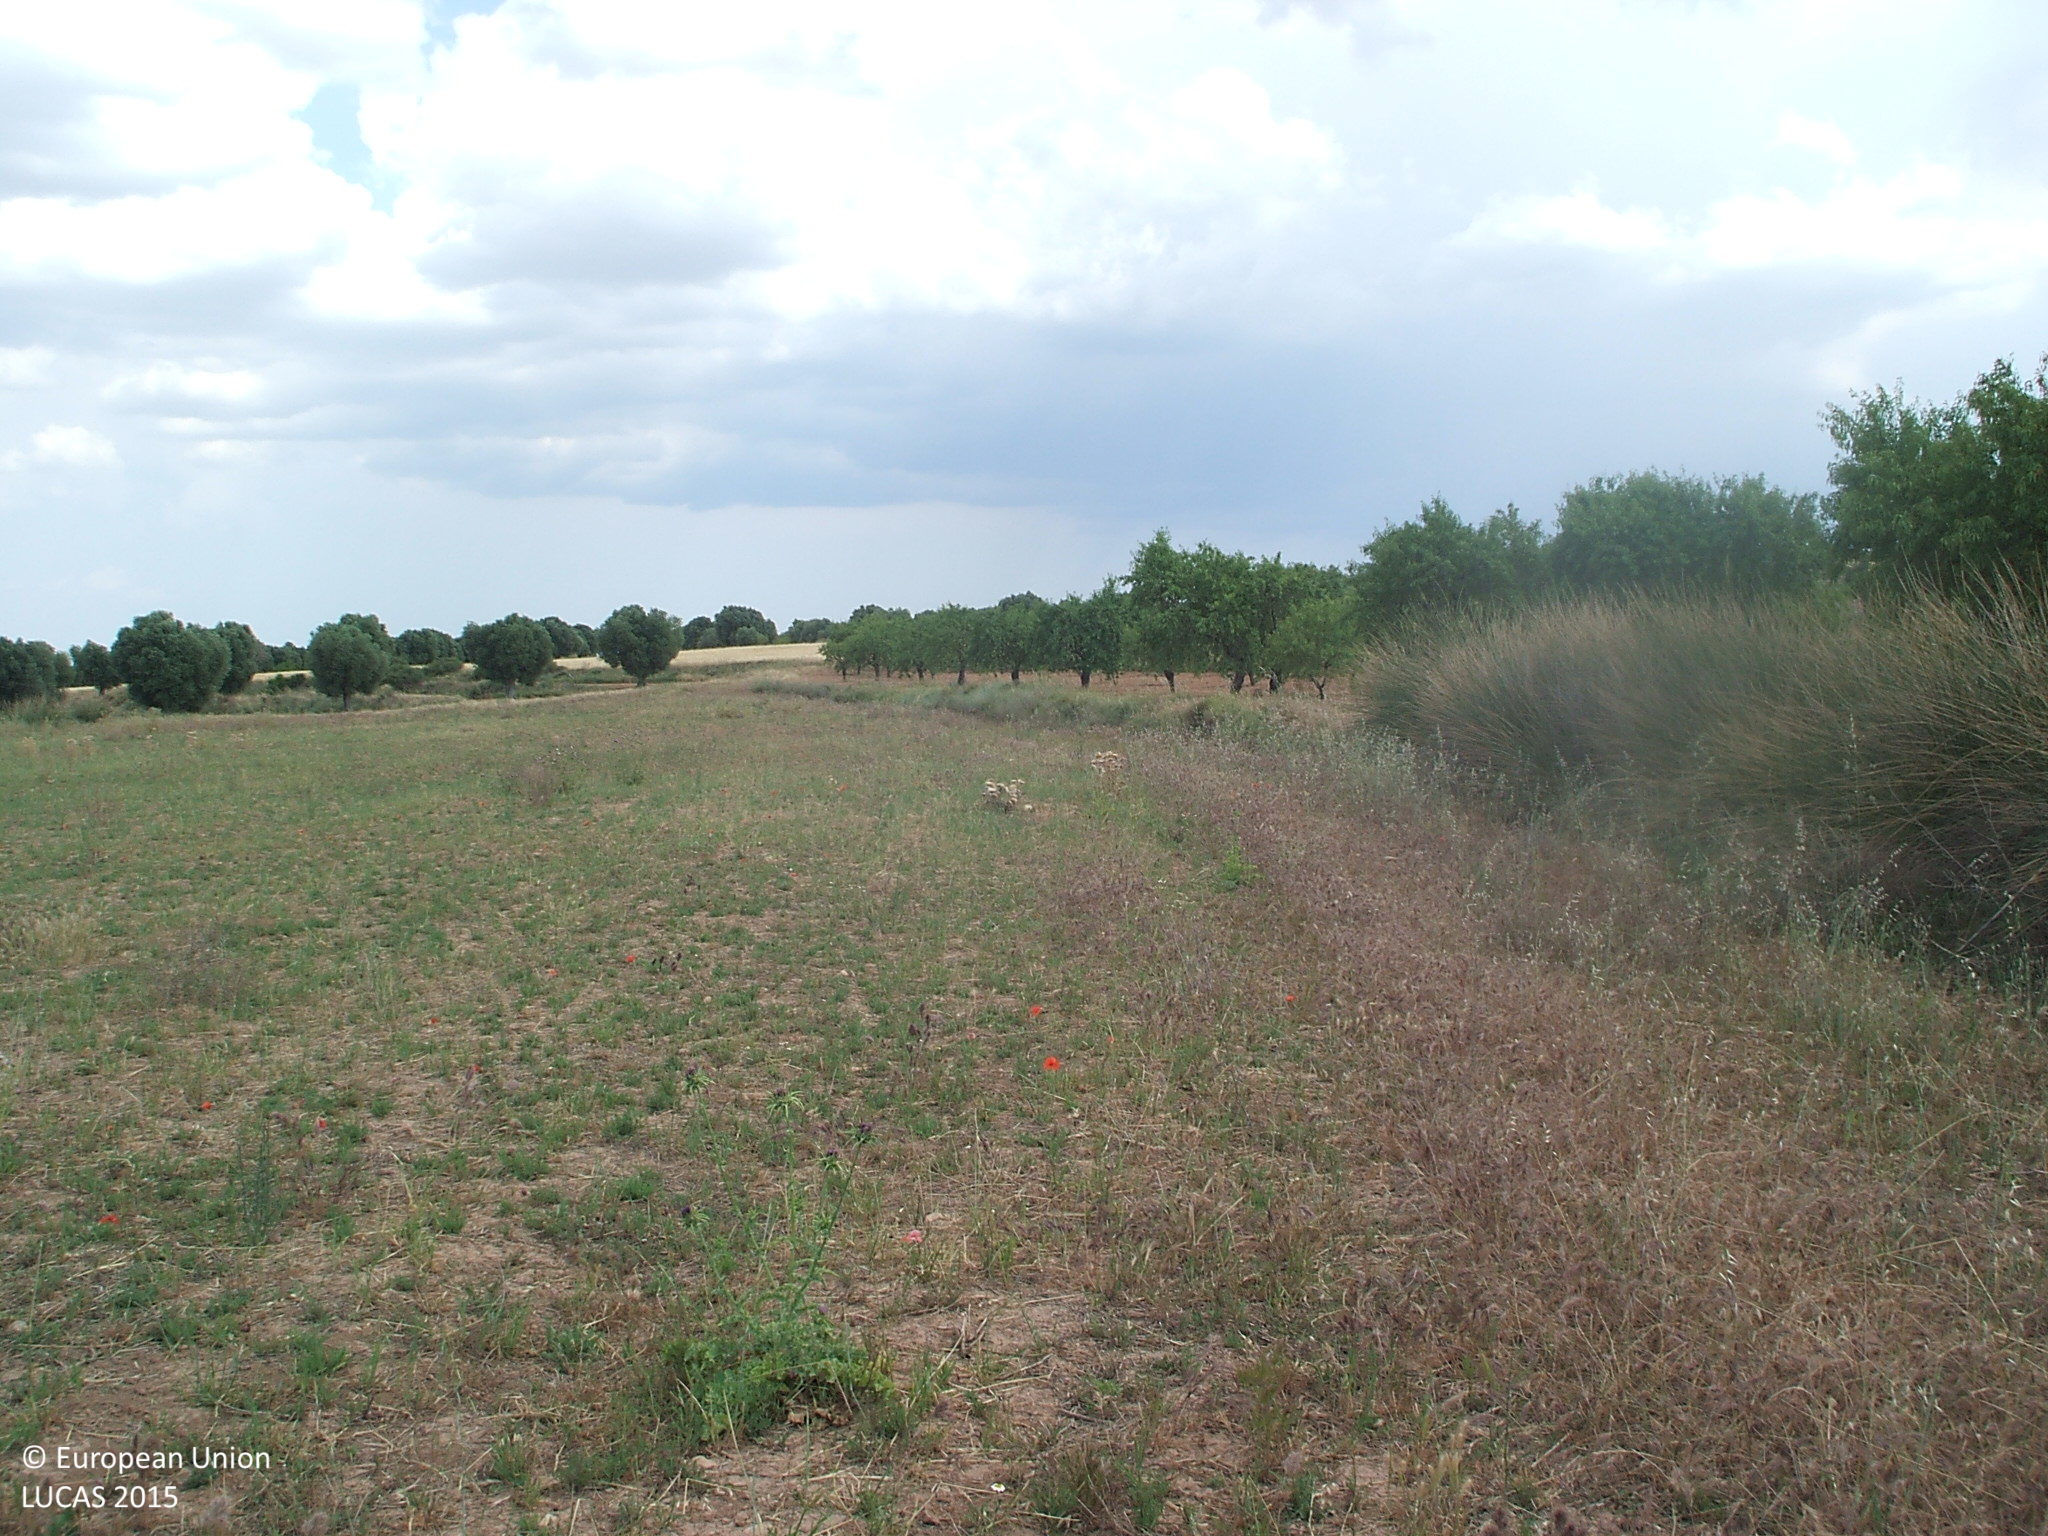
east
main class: Grassland
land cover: Spontaneously vegetated surfaces
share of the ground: 50 - 75 %
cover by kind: herbaceous plants 65 %, unconsolidated bare surface 35 %
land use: Fallow land
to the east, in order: Spontaneously vegetated surfaces; Grassland without tree/shrub cover; Olive groves; Shruby margins; Olive groves; Grassland with sparse tree/shrub cover; Tracks; Grass margins; Olive groves
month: June
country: ES
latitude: 40.9817
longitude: -0.2924
